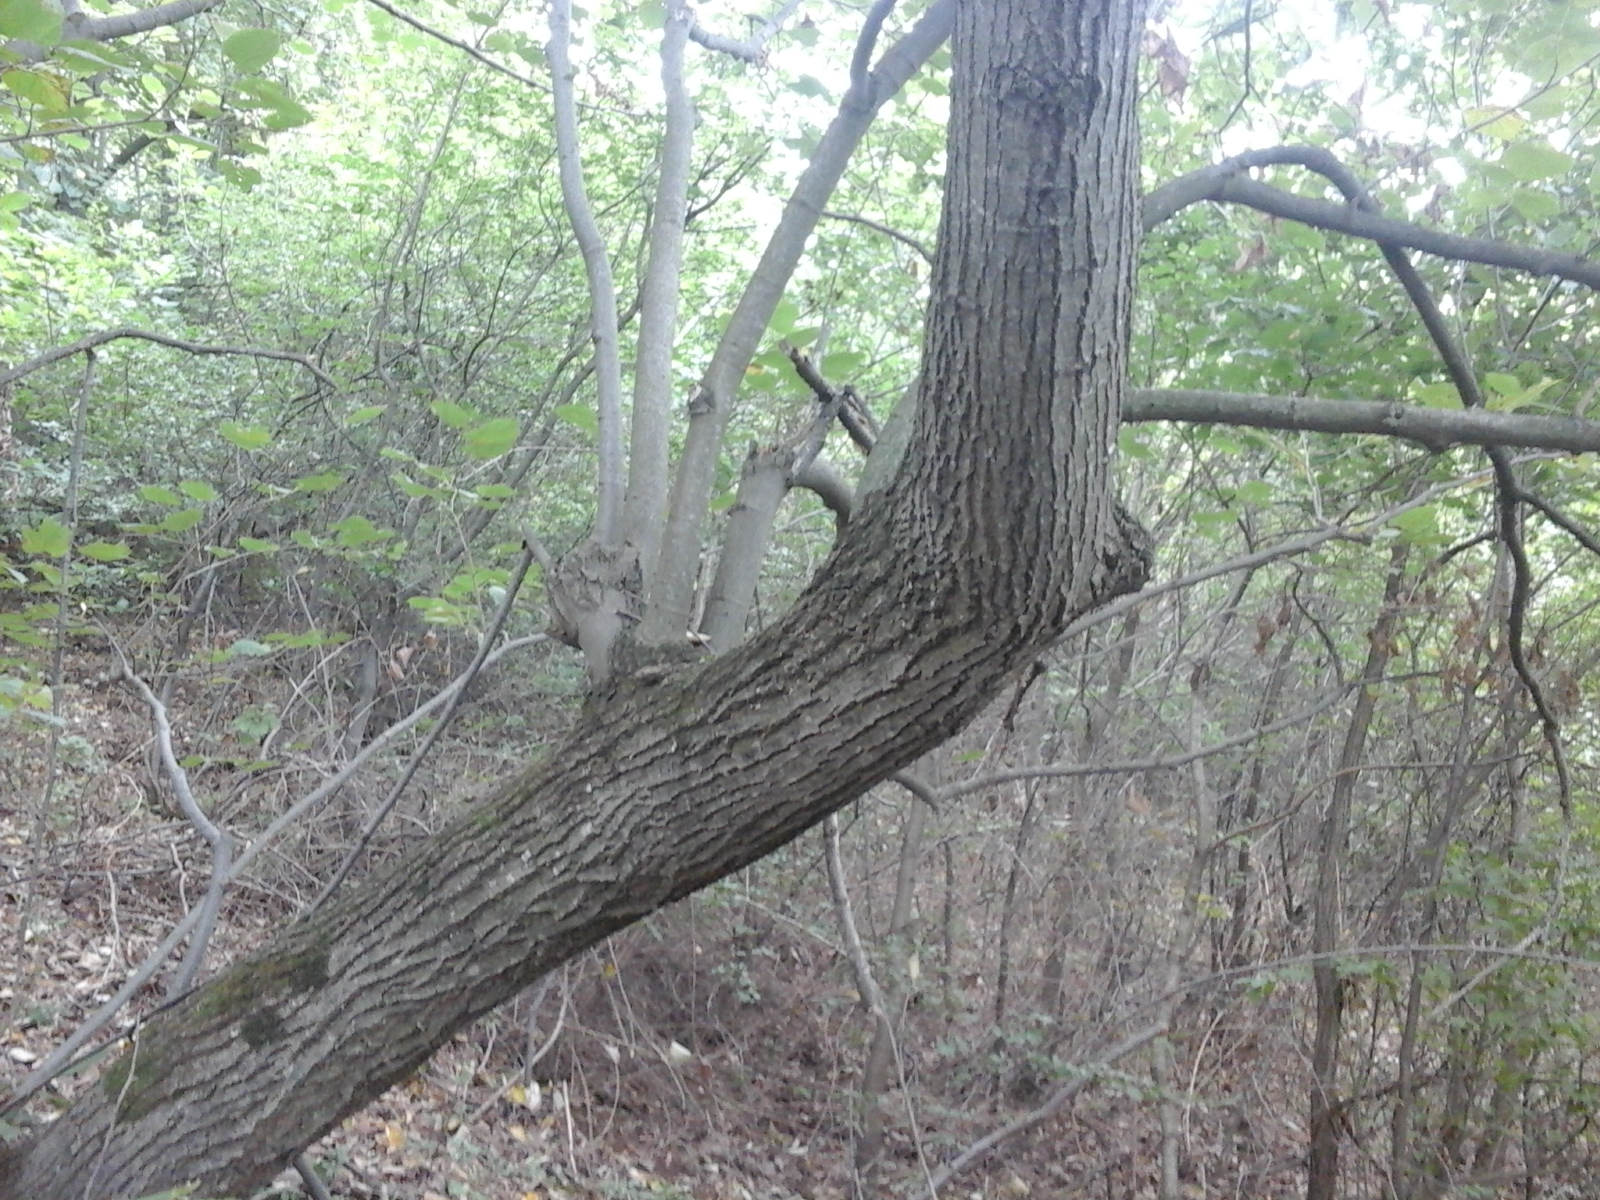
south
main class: Woodland
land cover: Broadleaved woodland
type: beech forest
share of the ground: > 75 %
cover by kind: broadleaved forest trees 100 %
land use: Forestry
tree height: > 5 m
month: August
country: RO
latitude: 46.2758
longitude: 21.6530
